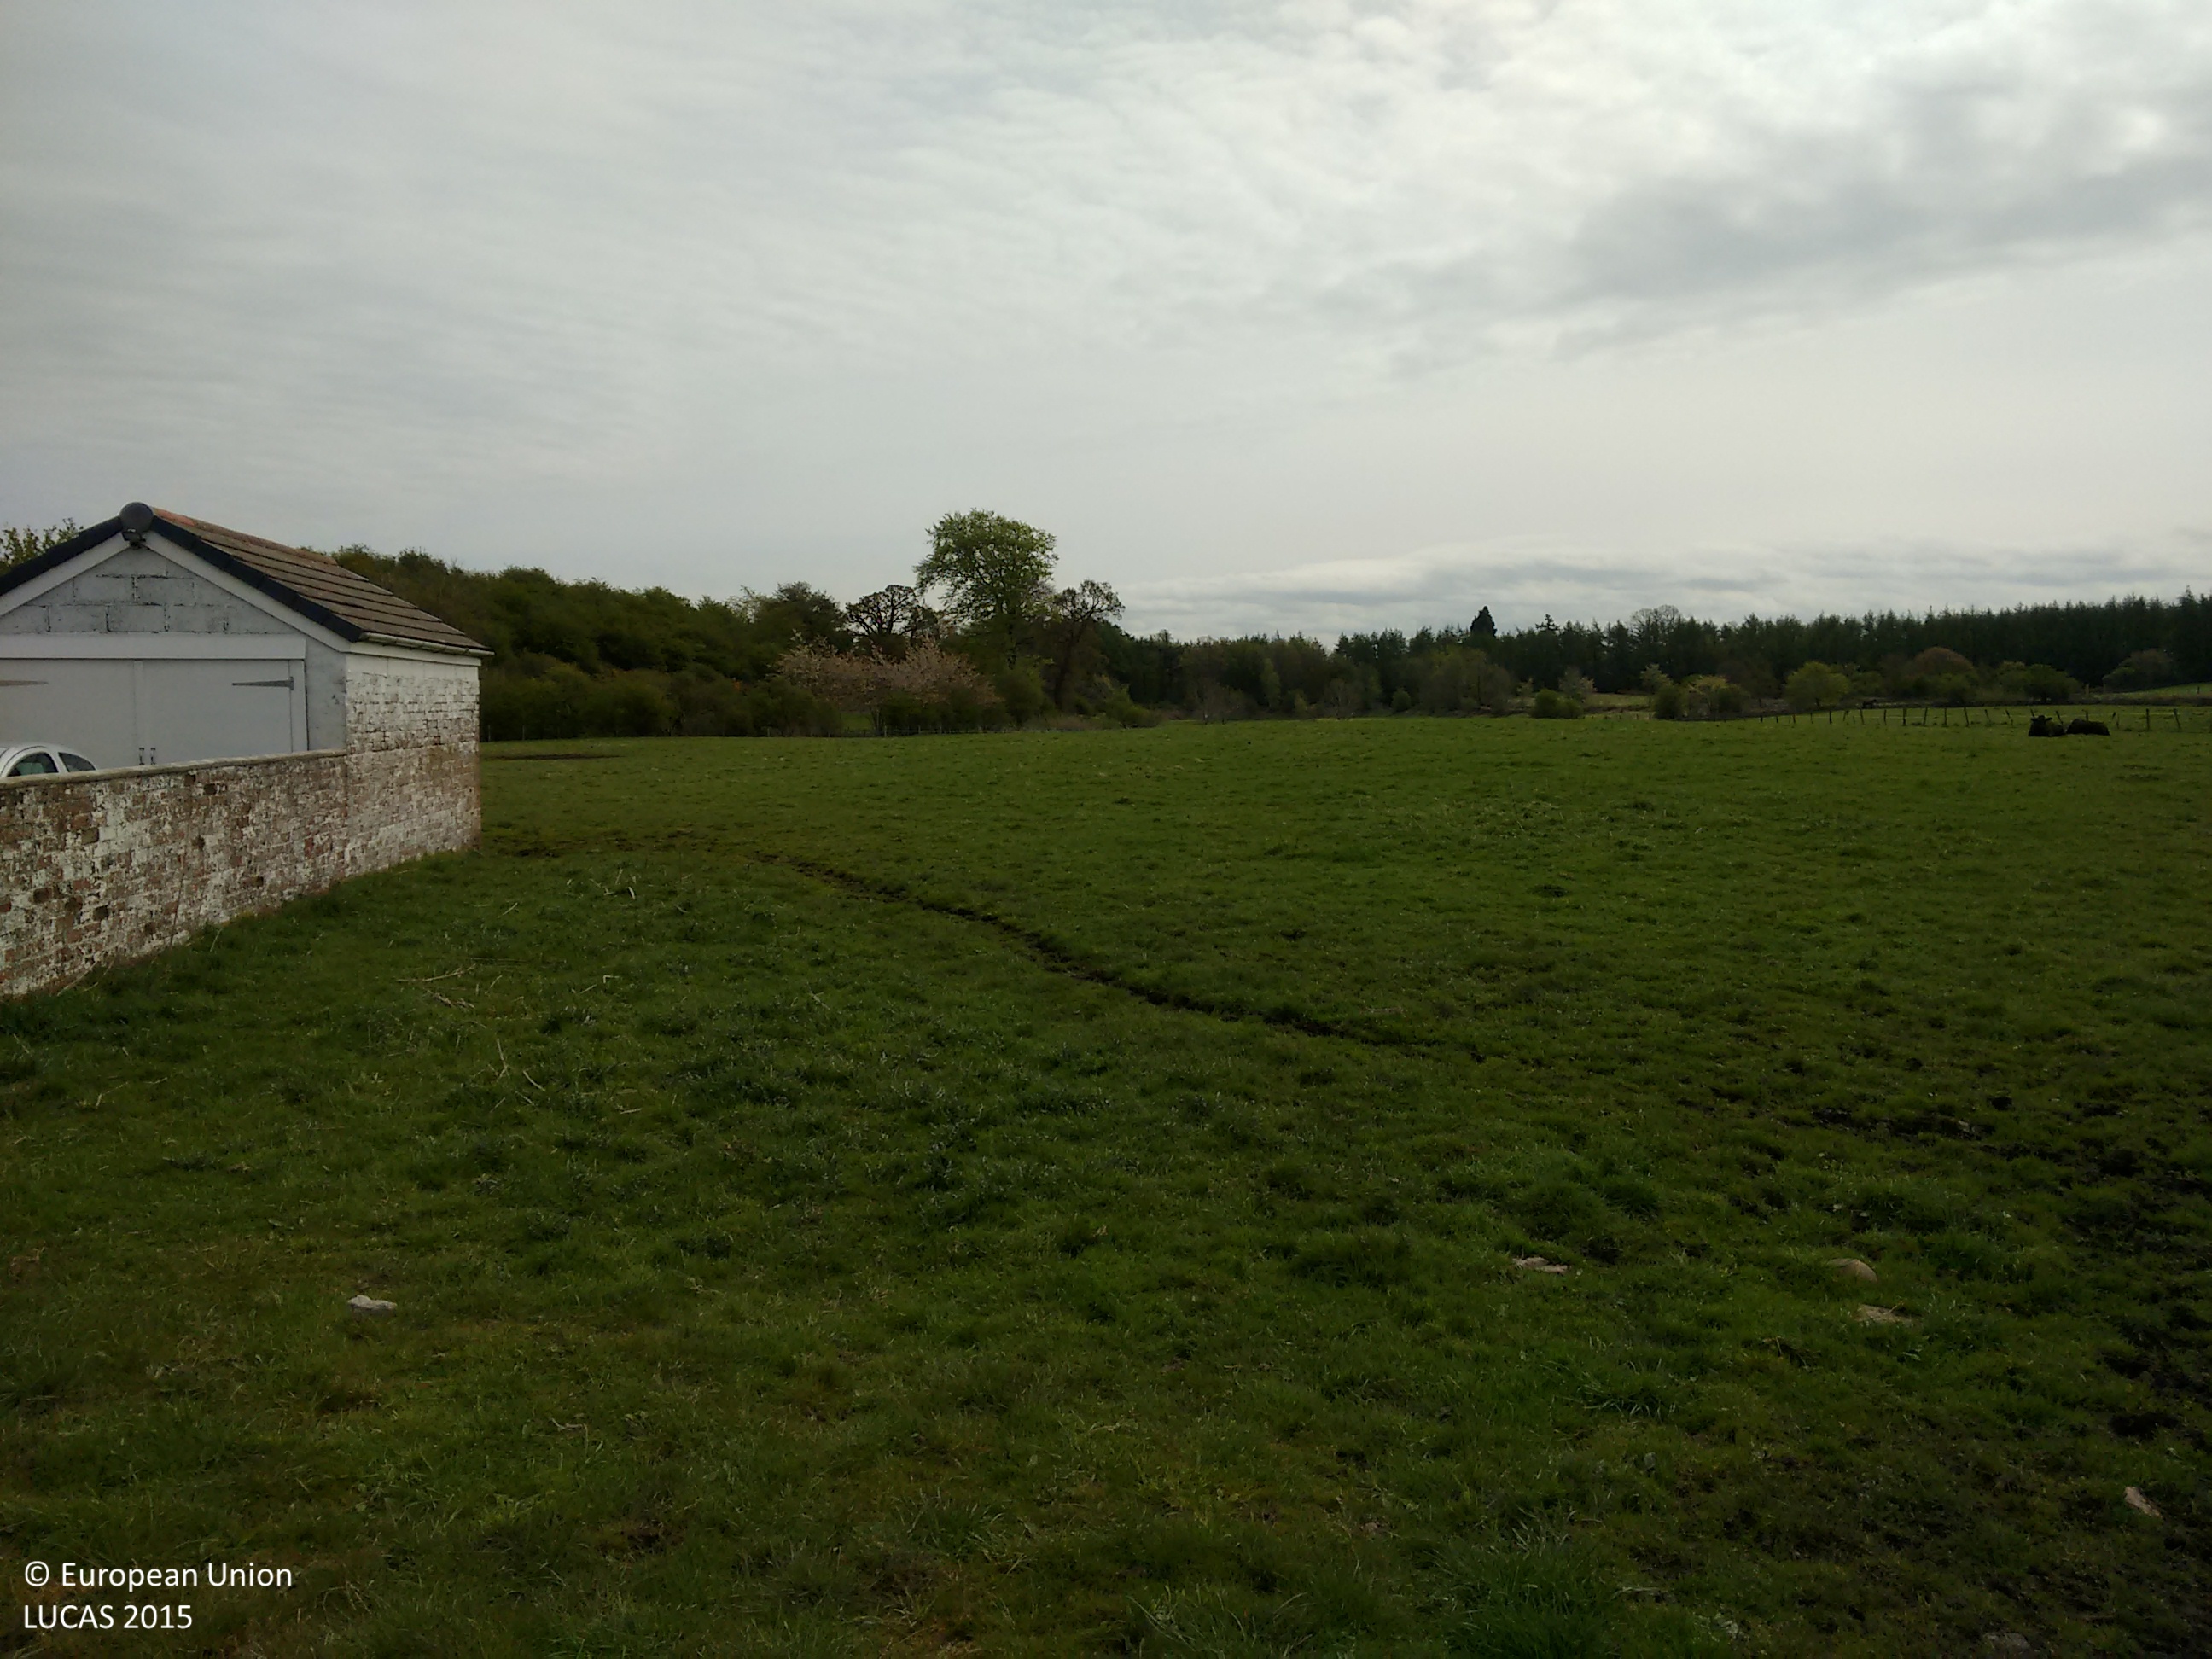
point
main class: Grassland
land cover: Grassland without tree/shrub cover
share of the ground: > 75 %
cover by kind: herbaceous plants 100 %
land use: Agriculture (excluding fallow land and kitchen gardens)
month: May
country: GB
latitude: 56.0819
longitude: -3.9205
